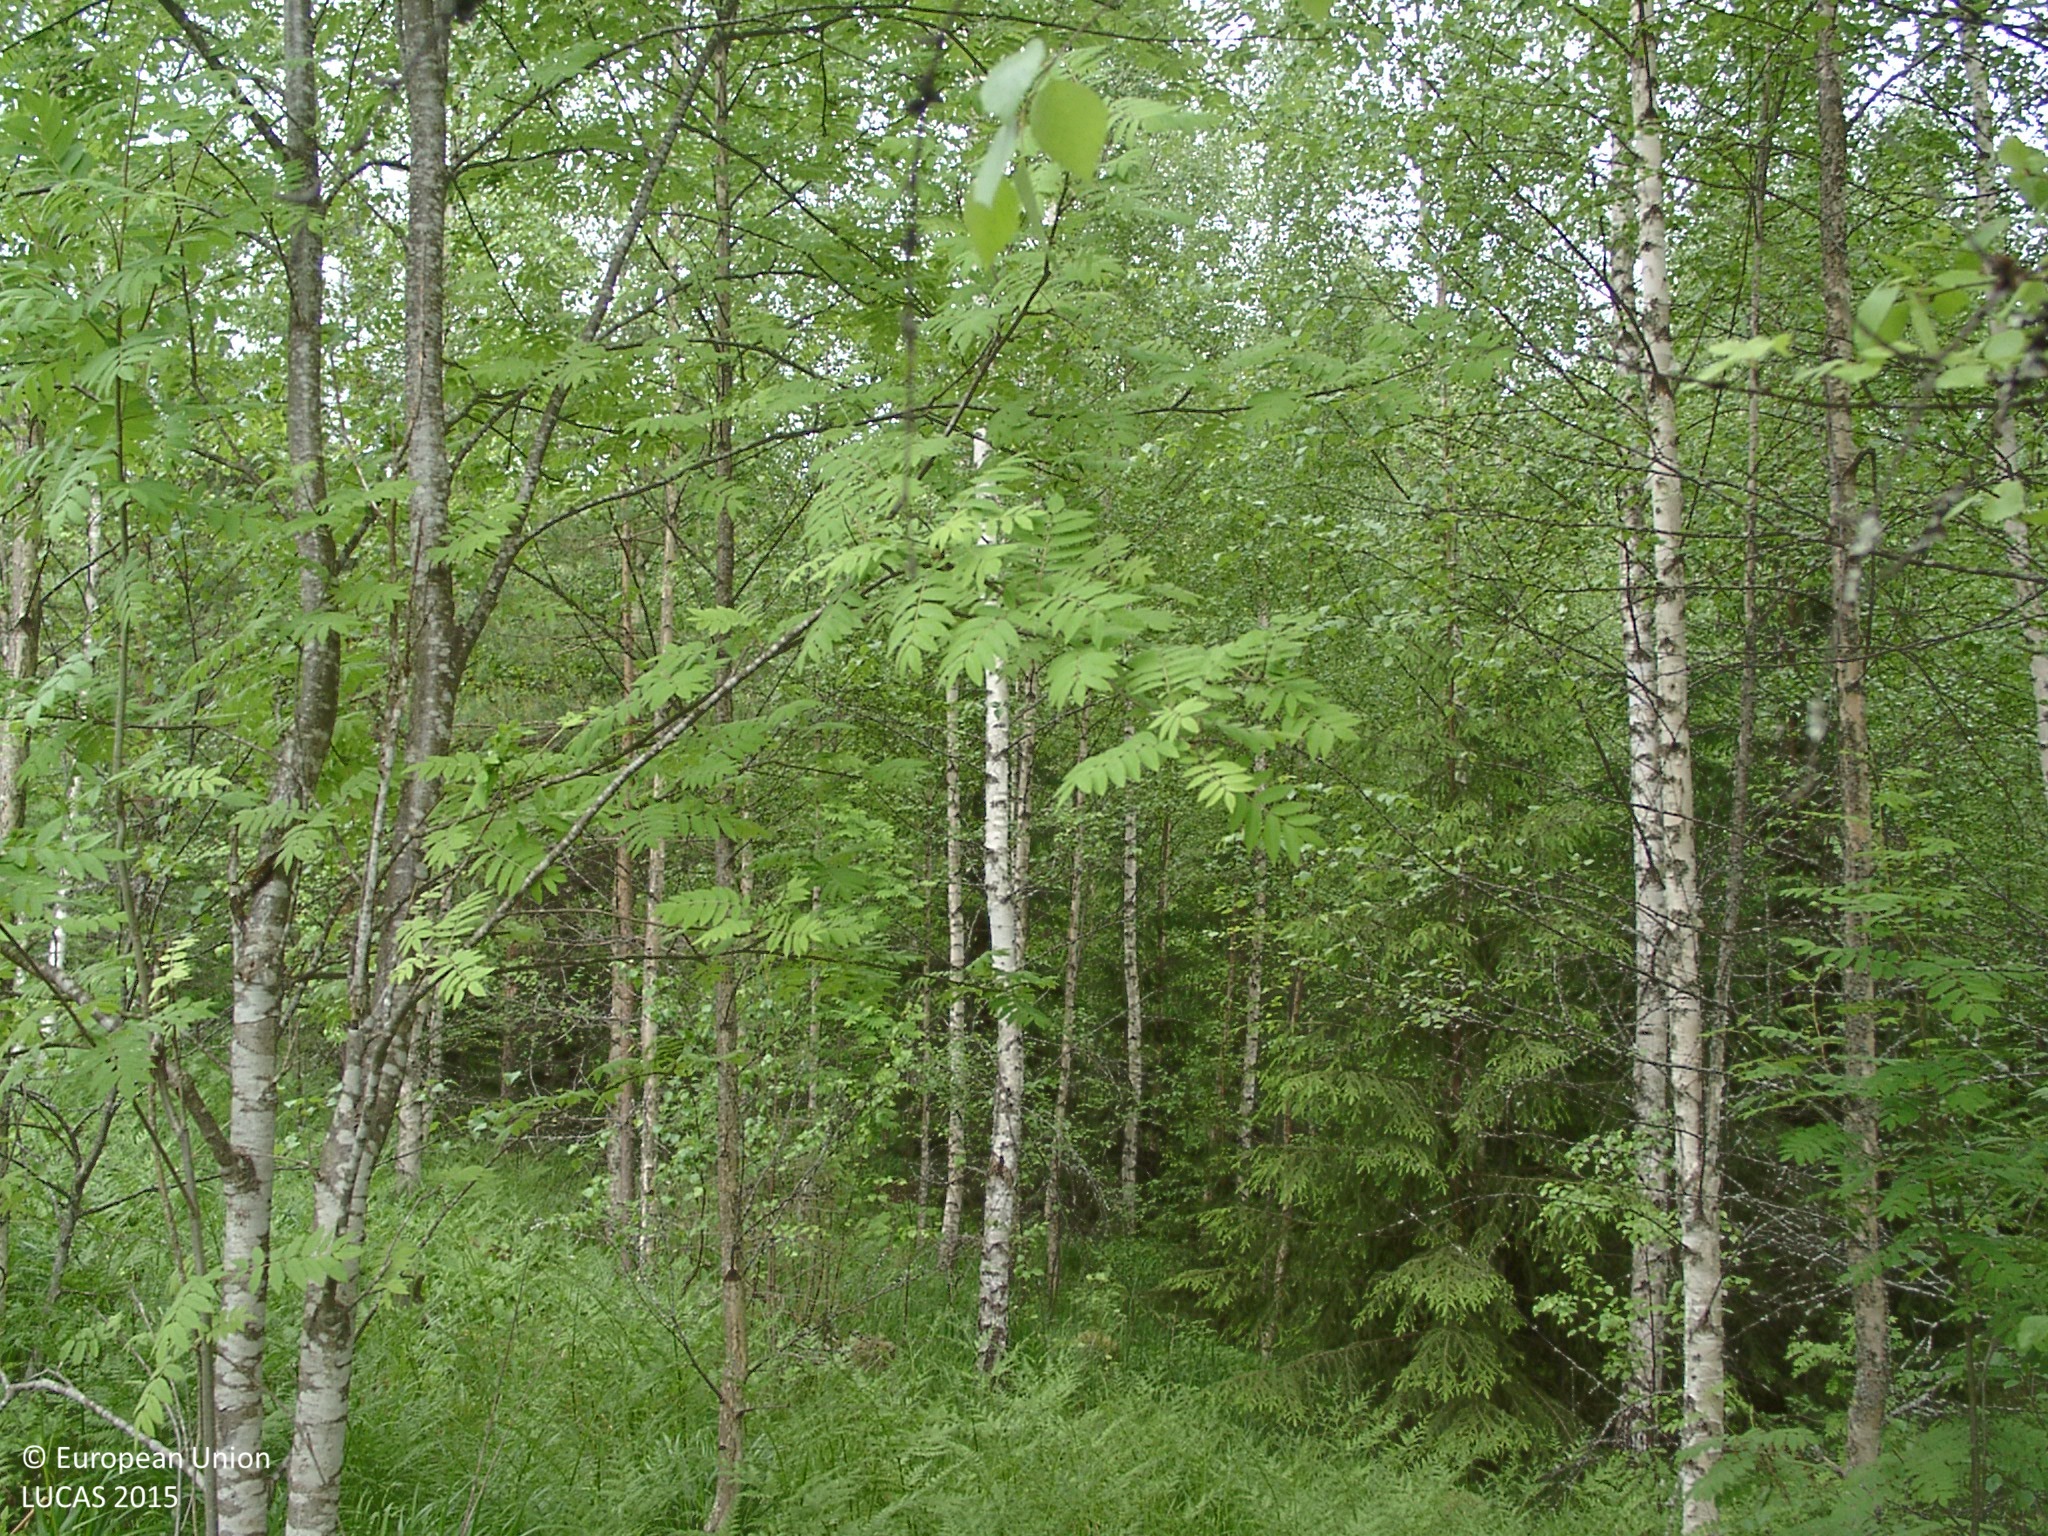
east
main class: Shrubland
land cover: Shrubland with sparse tree cover
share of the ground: 25 - 50 %
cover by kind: herbaceous plants 50 %, shrubs 40 %, broadleaved forest trees 5 %, consolidated bare surface 5 %
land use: Forestry
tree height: < 5 m
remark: Clear cut
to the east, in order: Broadleaved woodland; Spruce dominated mixed woodland; Tracks; Other mixed woodland; Spruce dominated mixed woodland
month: June
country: FI
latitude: 61.6080
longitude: 24.7125
